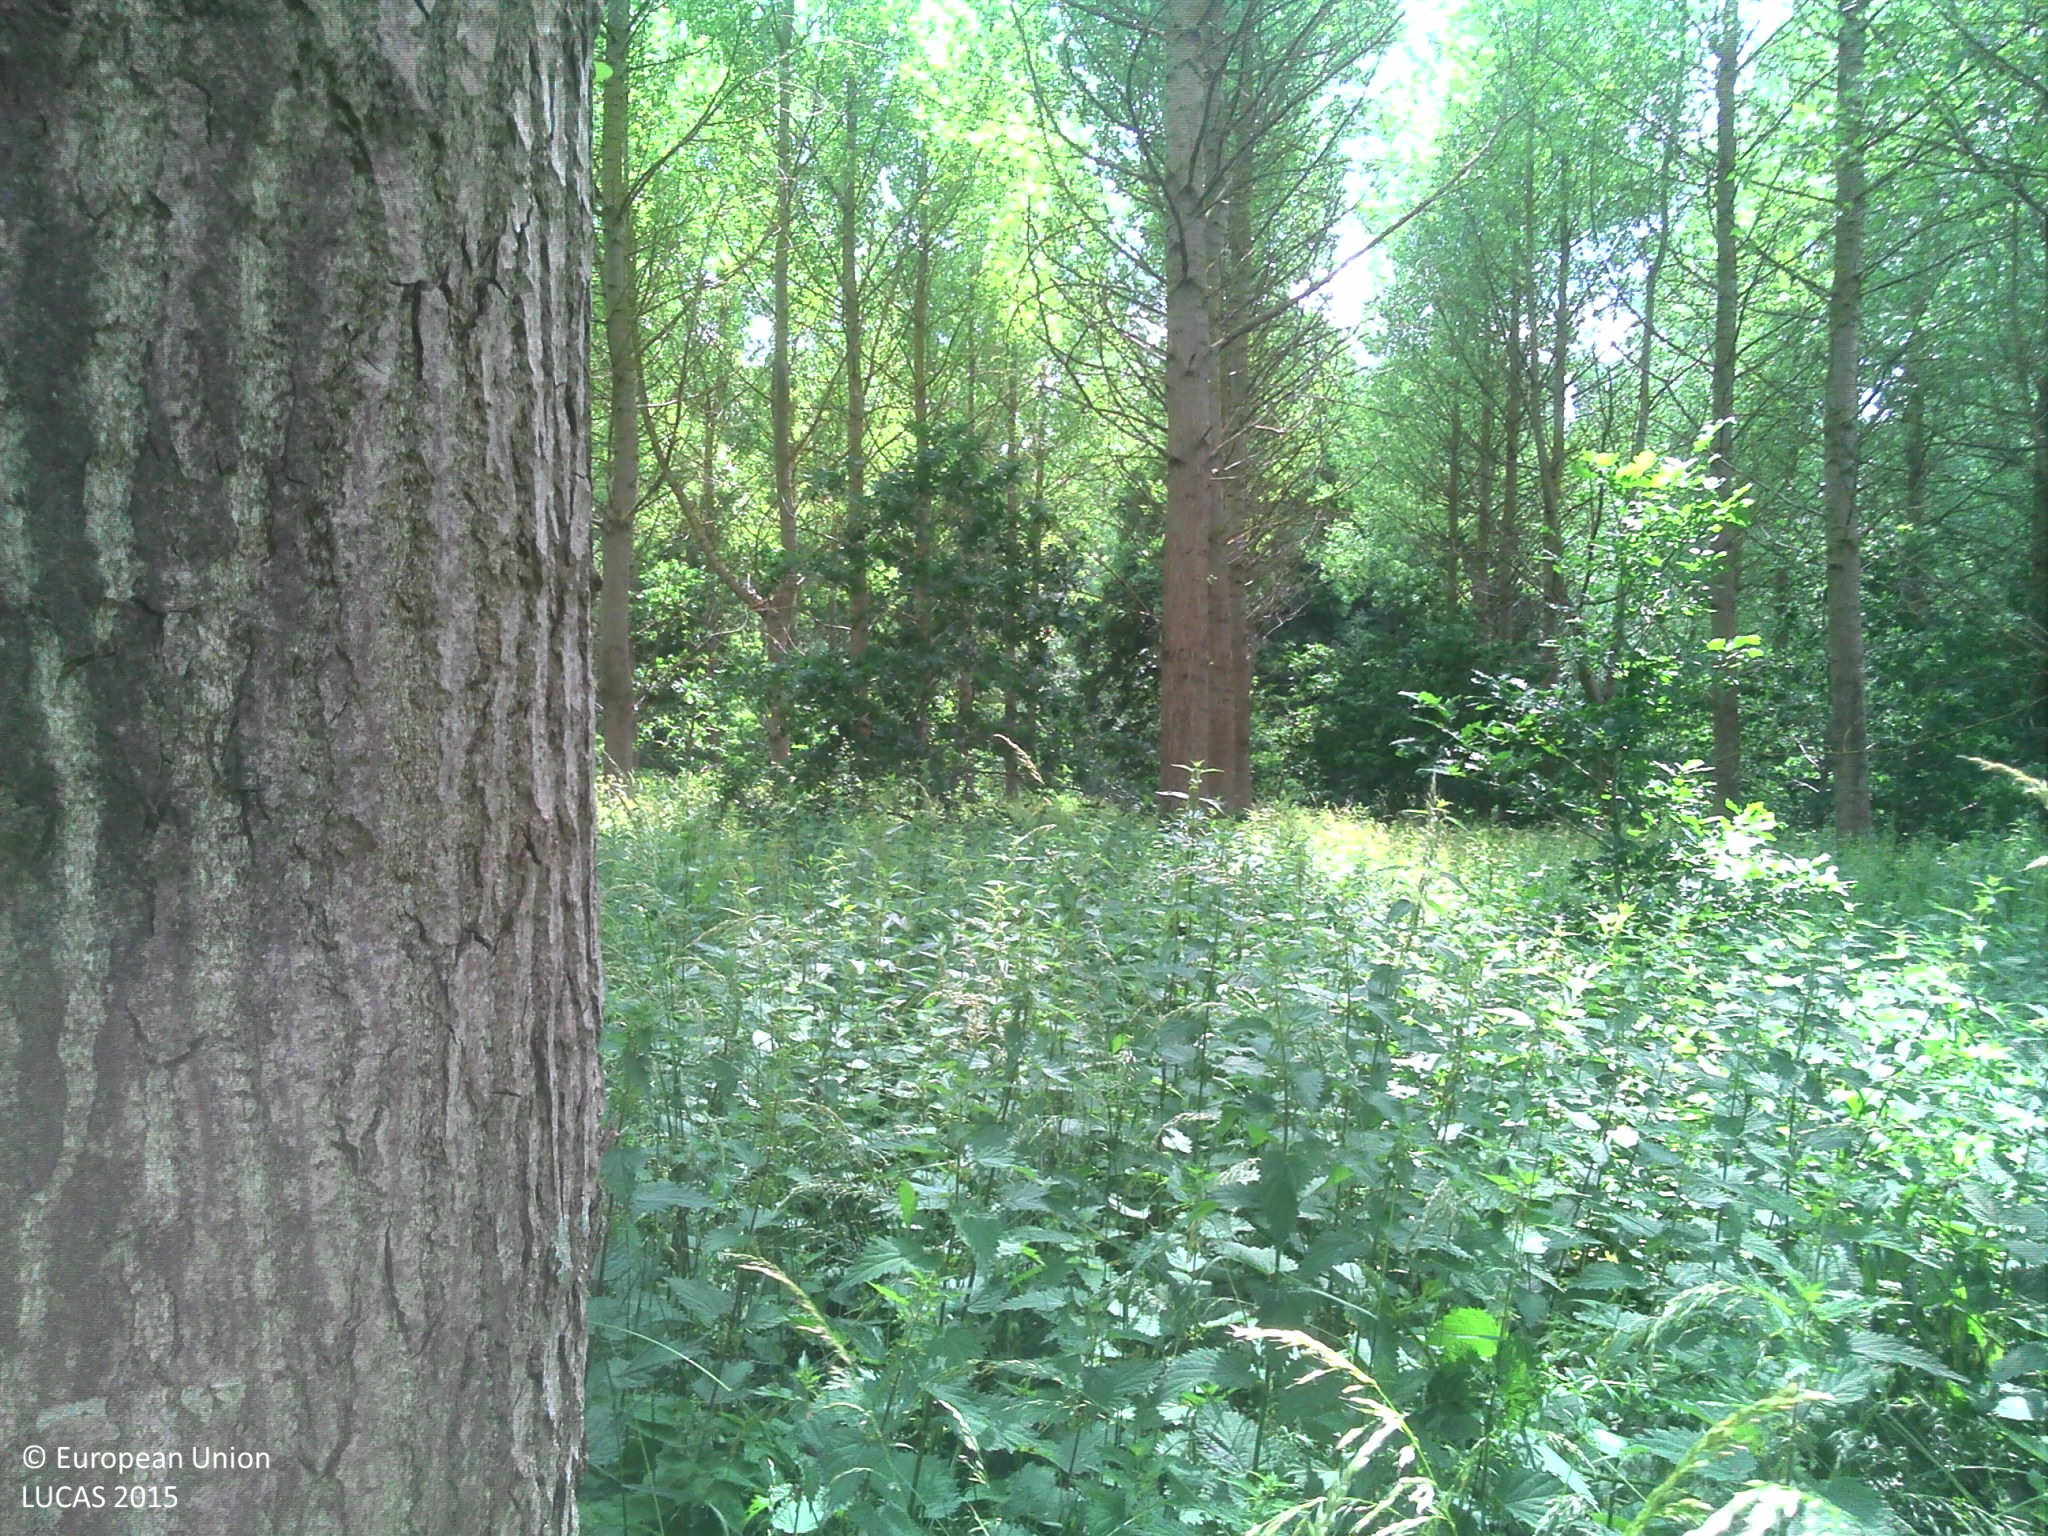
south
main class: Woodland
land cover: Broadleaved woodland
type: exotic forest
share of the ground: > 75 %
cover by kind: broadleaved forest trees 85 %, shrubs 10 %, herbaceous plants 5 %
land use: Forestry
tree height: > 5 m
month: June
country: BE
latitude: 50.9202
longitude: 4.5762
